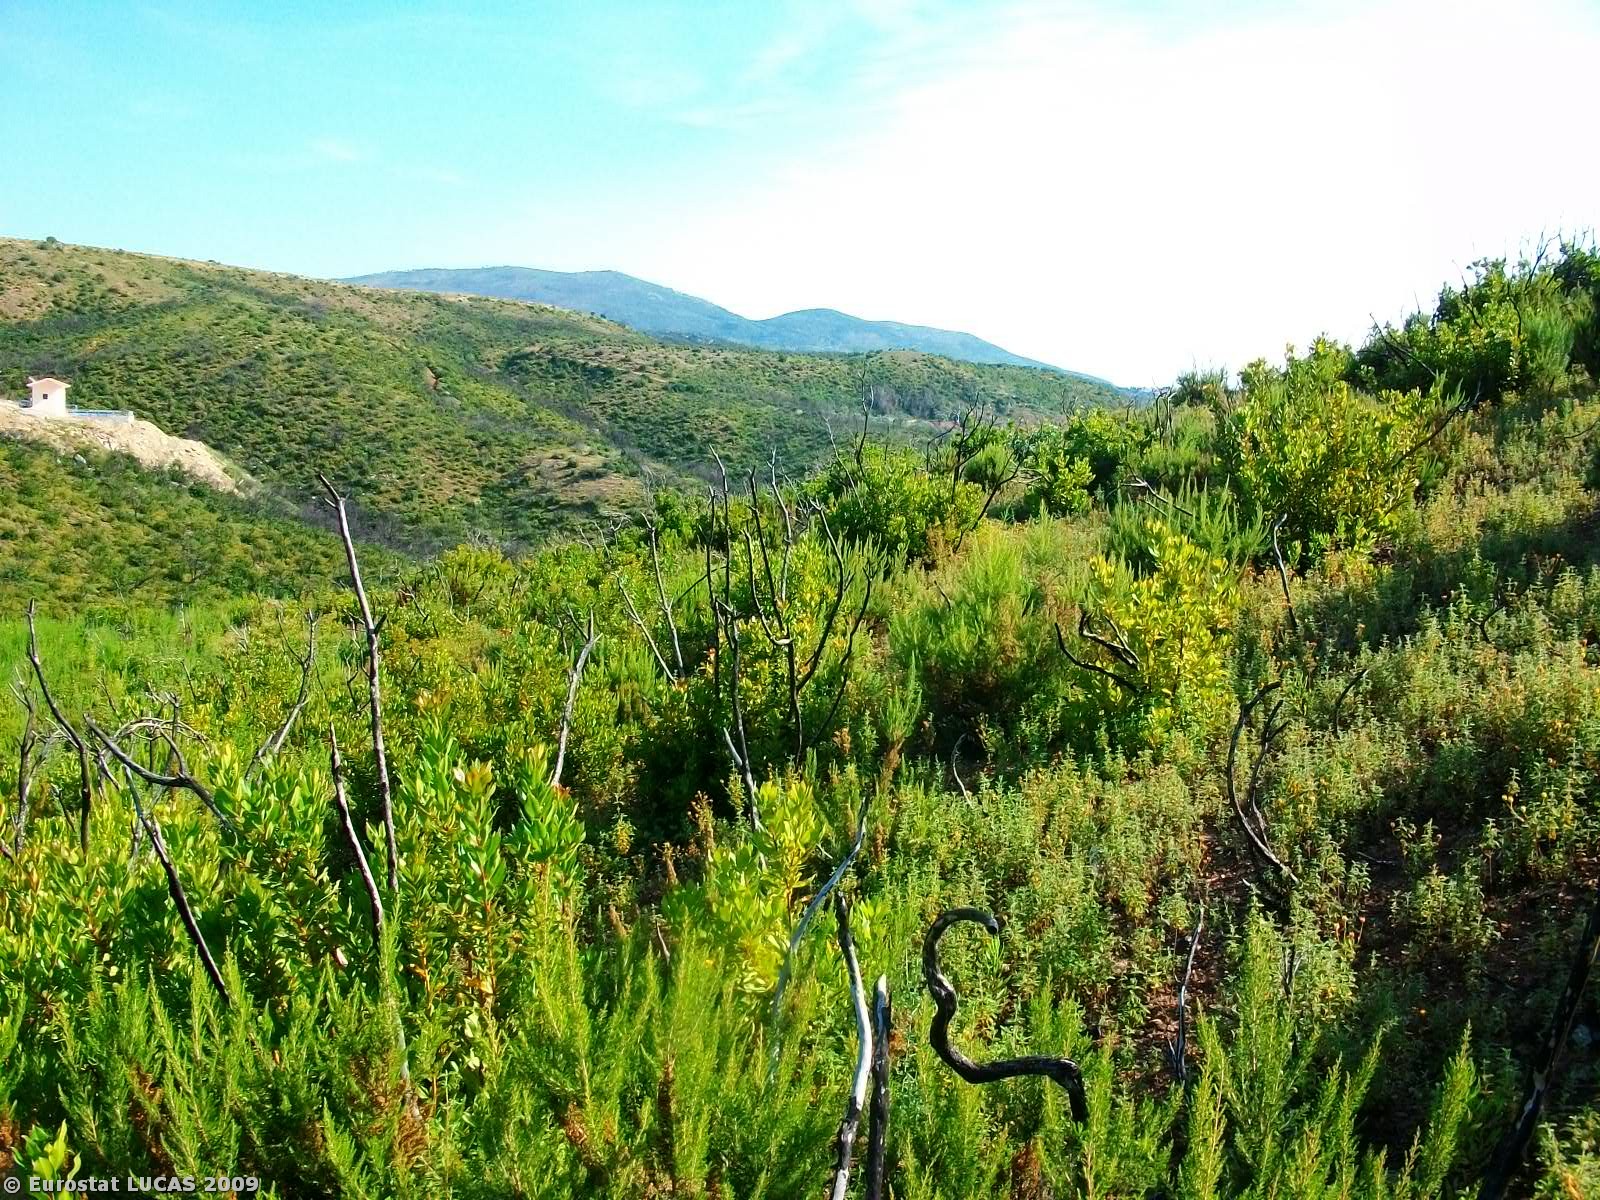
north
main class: Shrubland
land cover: Shrubland without tree cover
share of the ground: > 75 %
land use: Unused
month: June
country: GR
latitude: 39.2559
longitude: 23.2389
